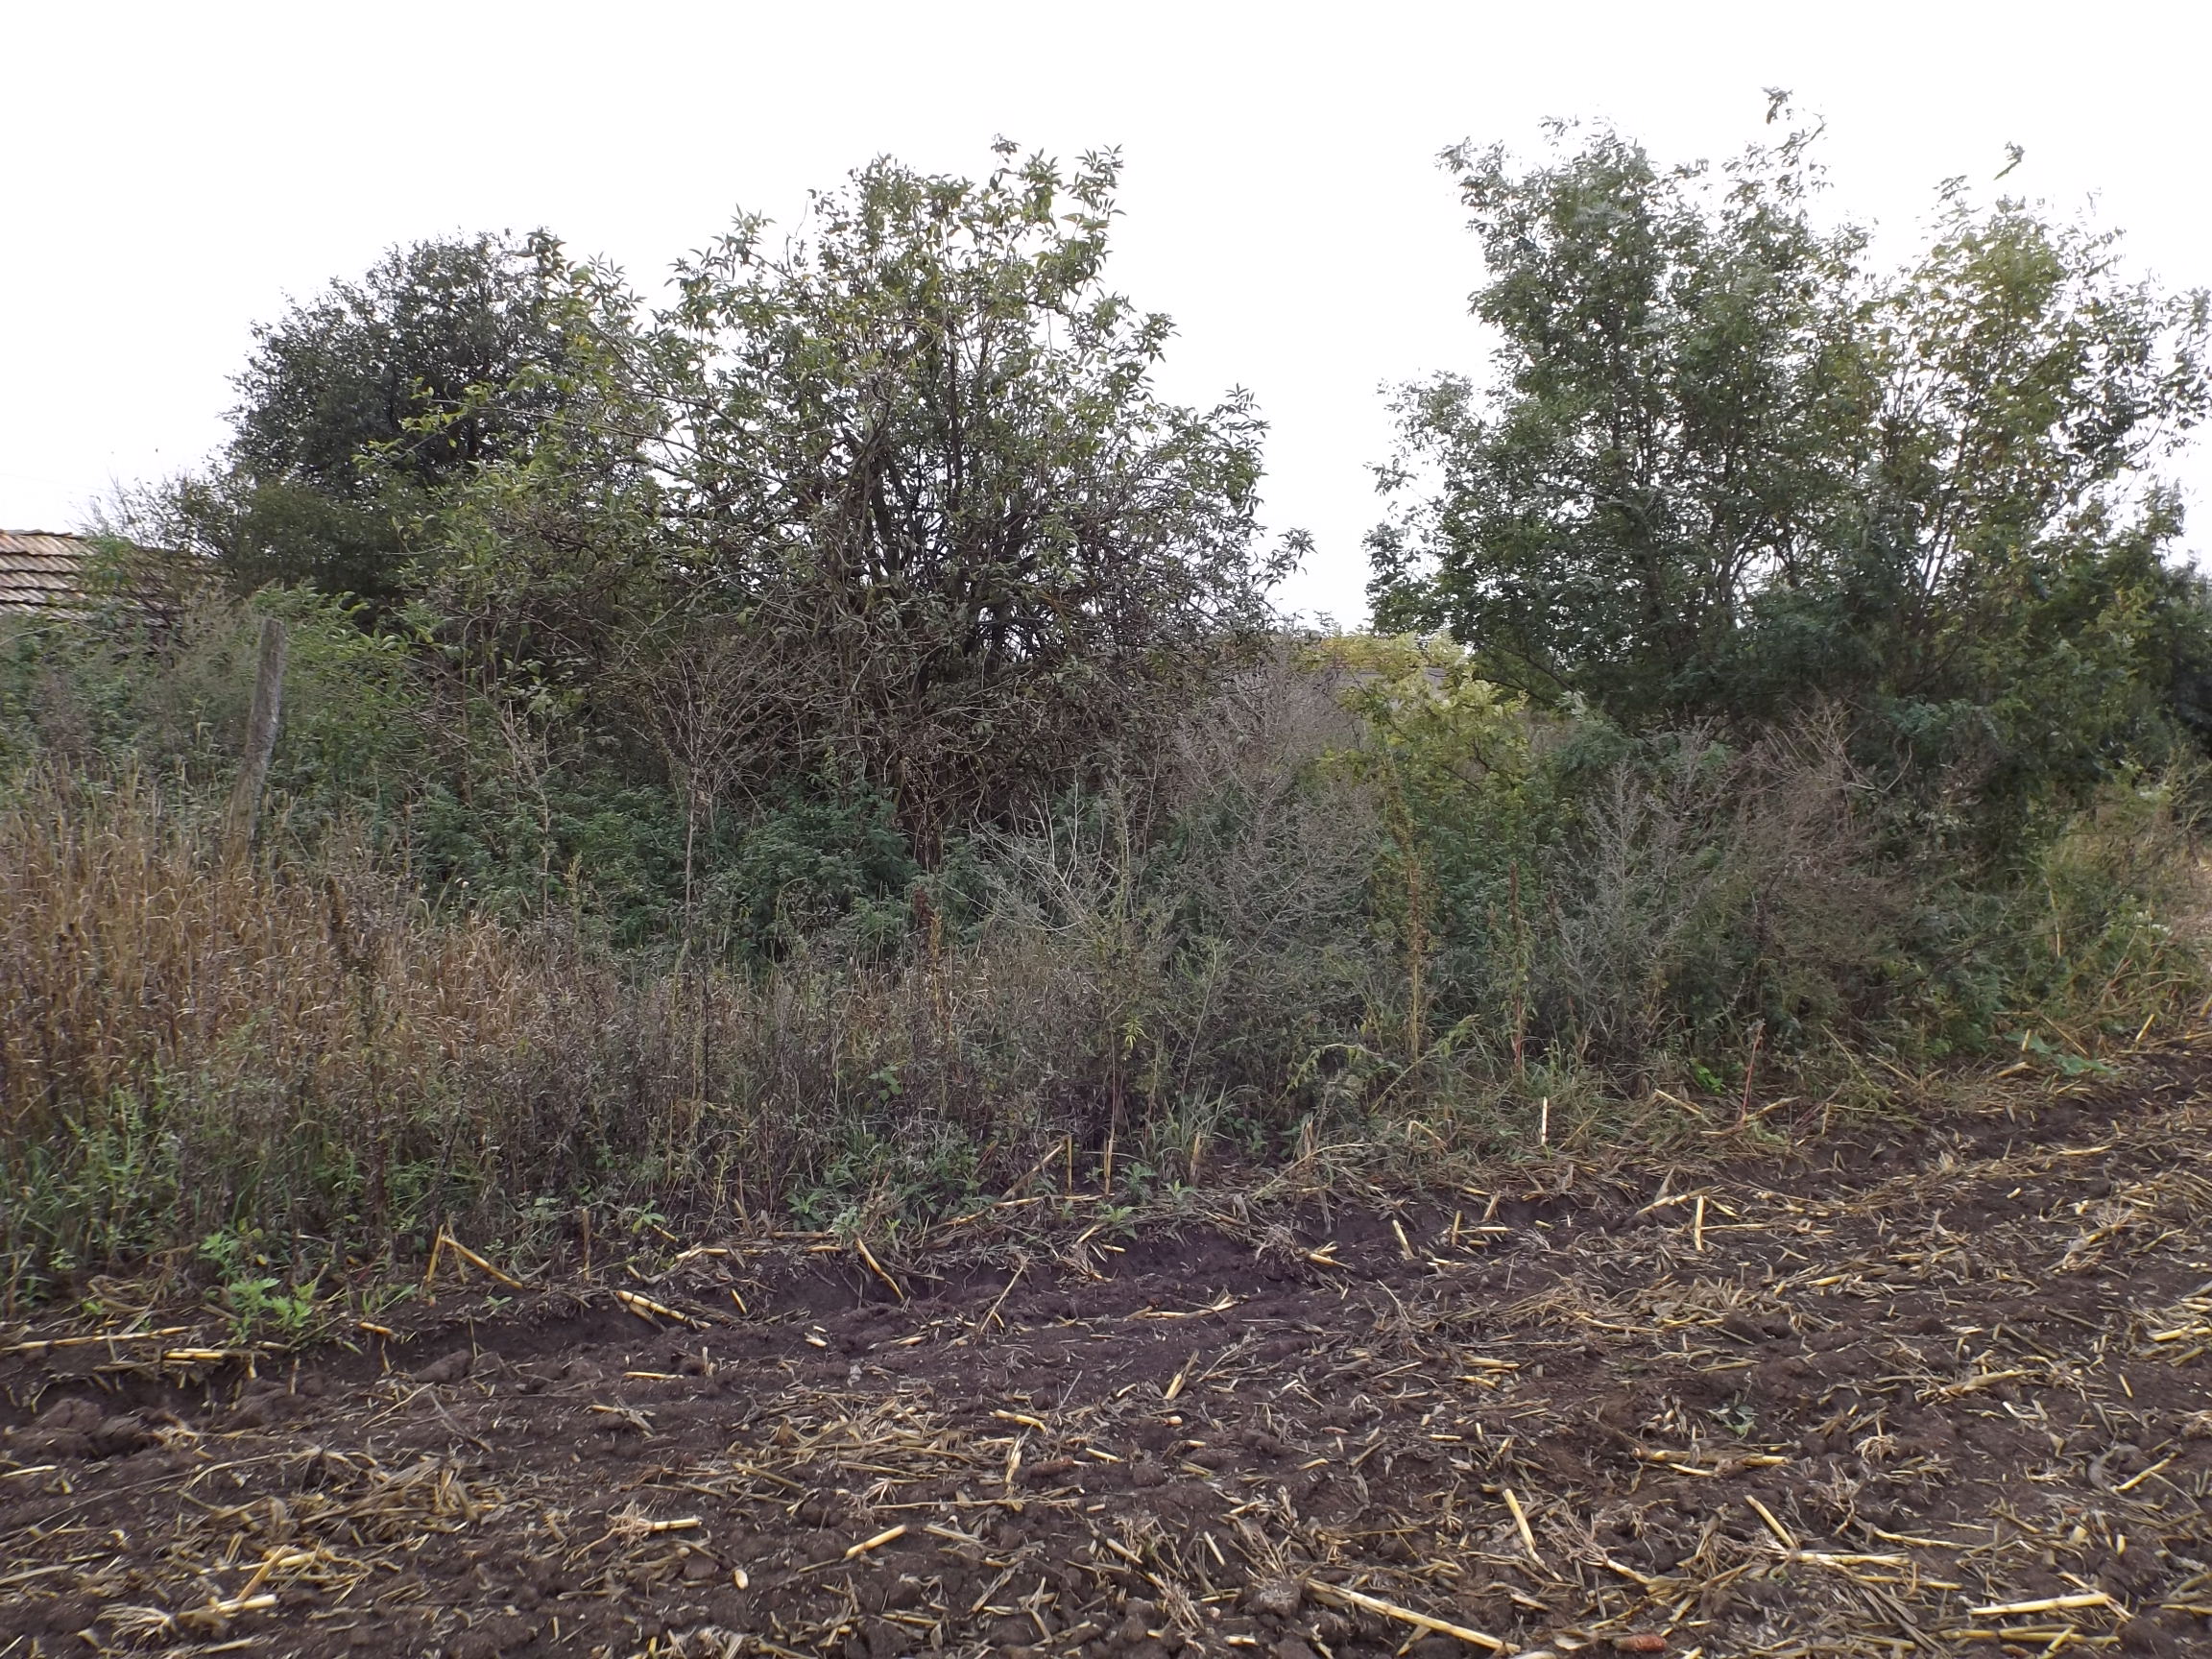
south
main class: Cropland
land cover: Maize
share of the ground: < 10 %
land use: Agriculture (excluding fallow land and kitchen gardens)
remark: Harvested field
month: September
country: BG
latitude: 43.5631
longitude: 27.5270
